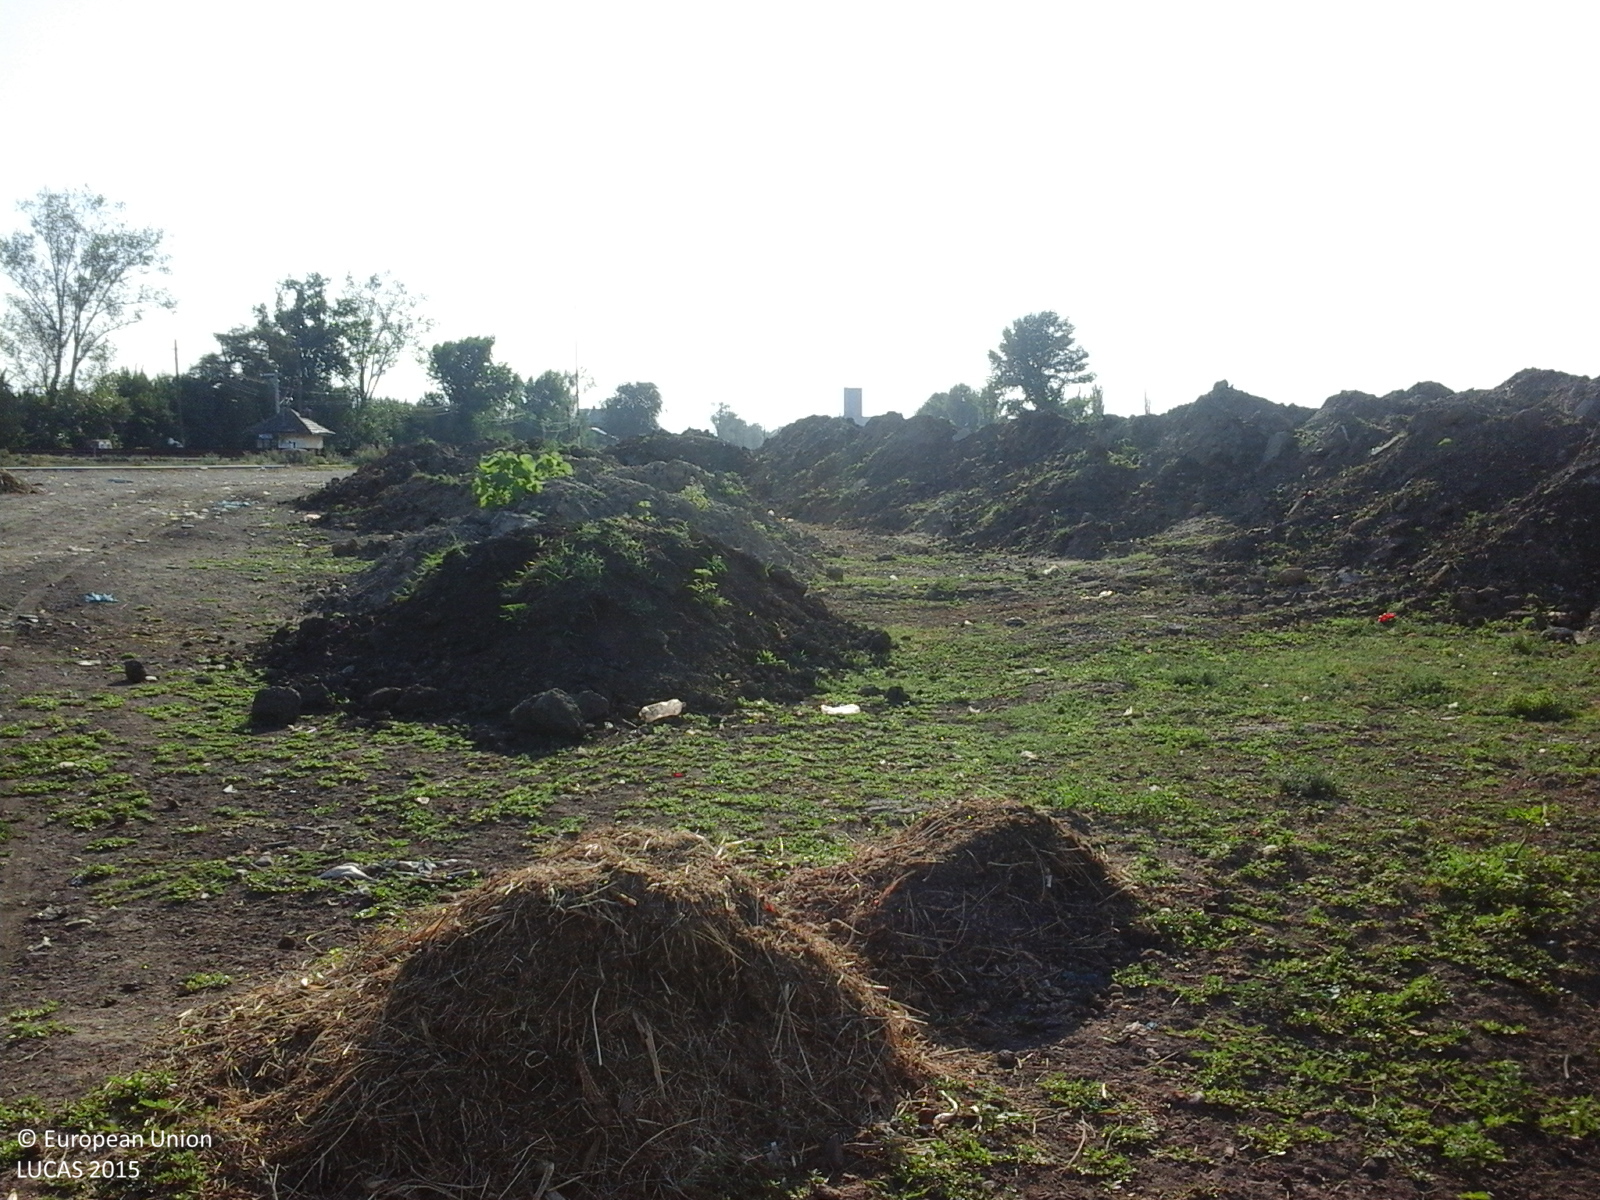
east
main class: Grassland
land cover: Spontaneously vegetated surfaces
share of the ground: 50 - 75 %
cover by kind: herbaceous plants 100 %
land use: Abandoned areas
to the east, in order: Spontaneously vegetated surfaces; Paved roads, cycling and walking lanes; Grassland without tree/shrub cover
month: August
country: RO
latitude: 44.0346
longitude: 23.1839
